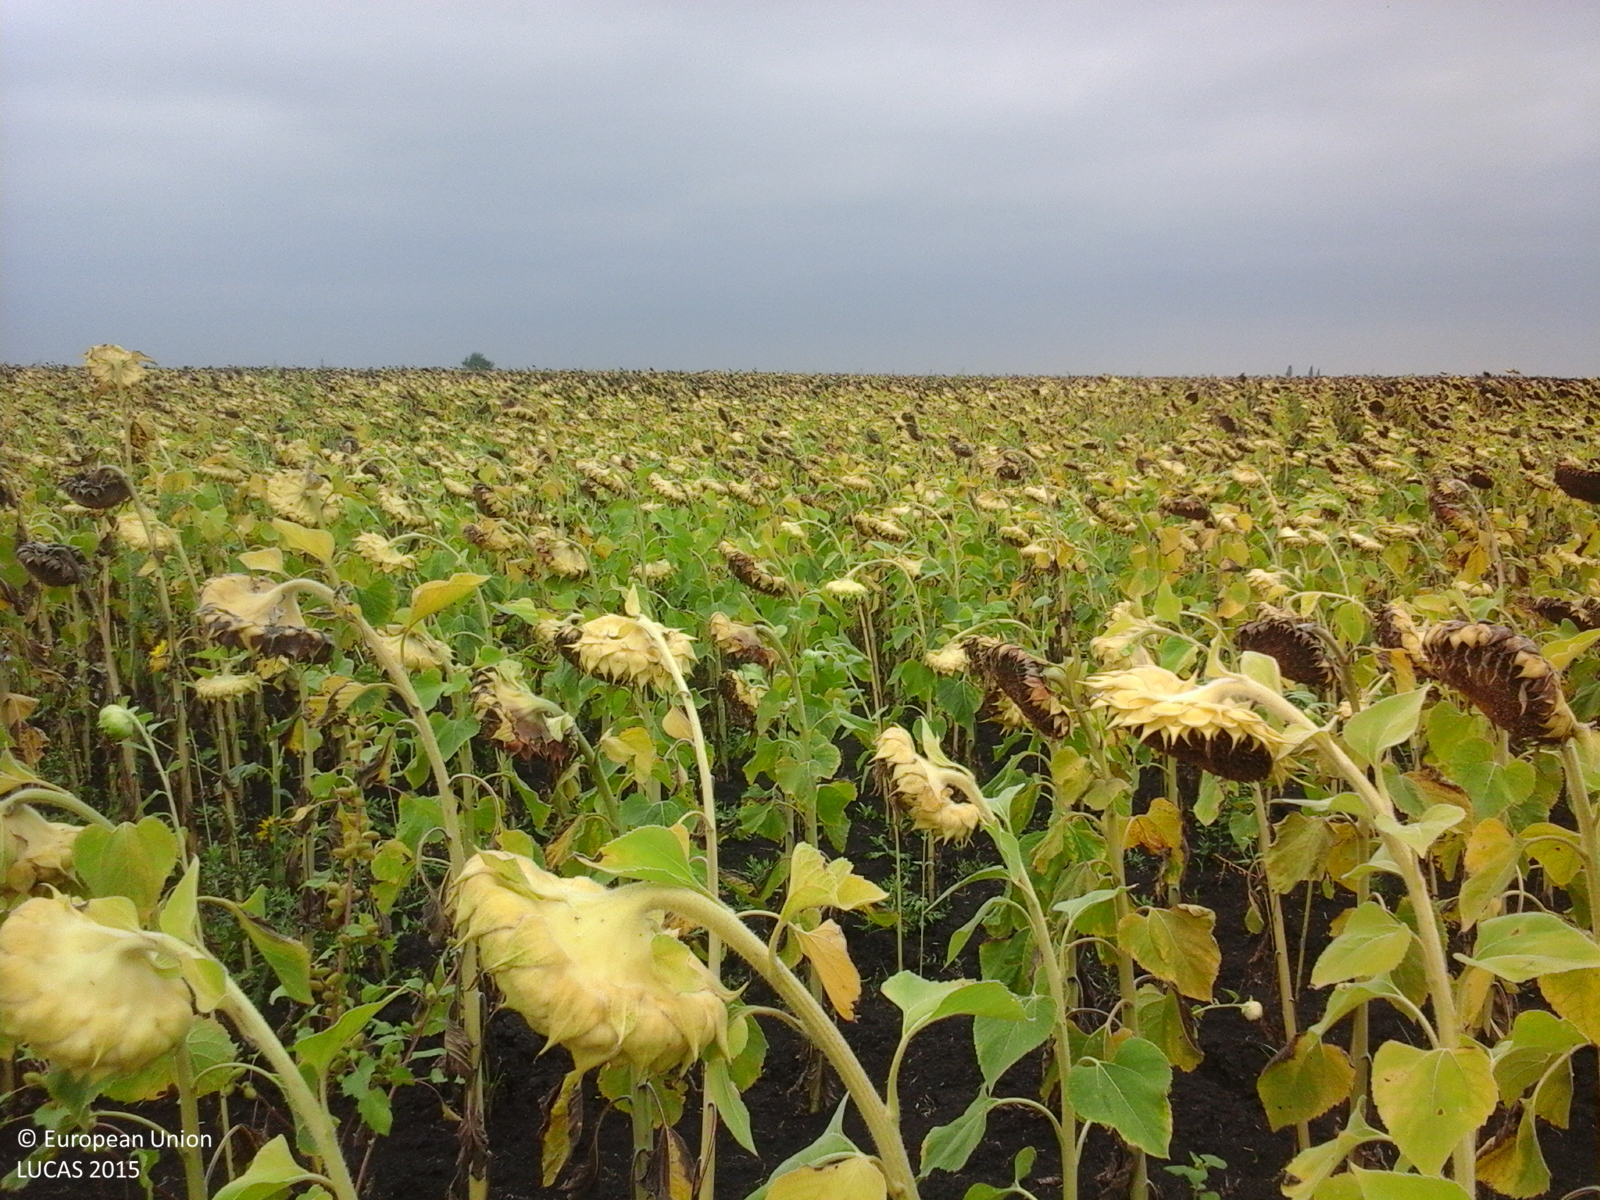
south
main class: Cropland
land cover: Sunflower
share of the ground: > 75 %
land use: Agriculture (excluding fallow land and kitchen gardens)
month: August
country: RO
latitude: 46.1163
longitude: 20.3882
